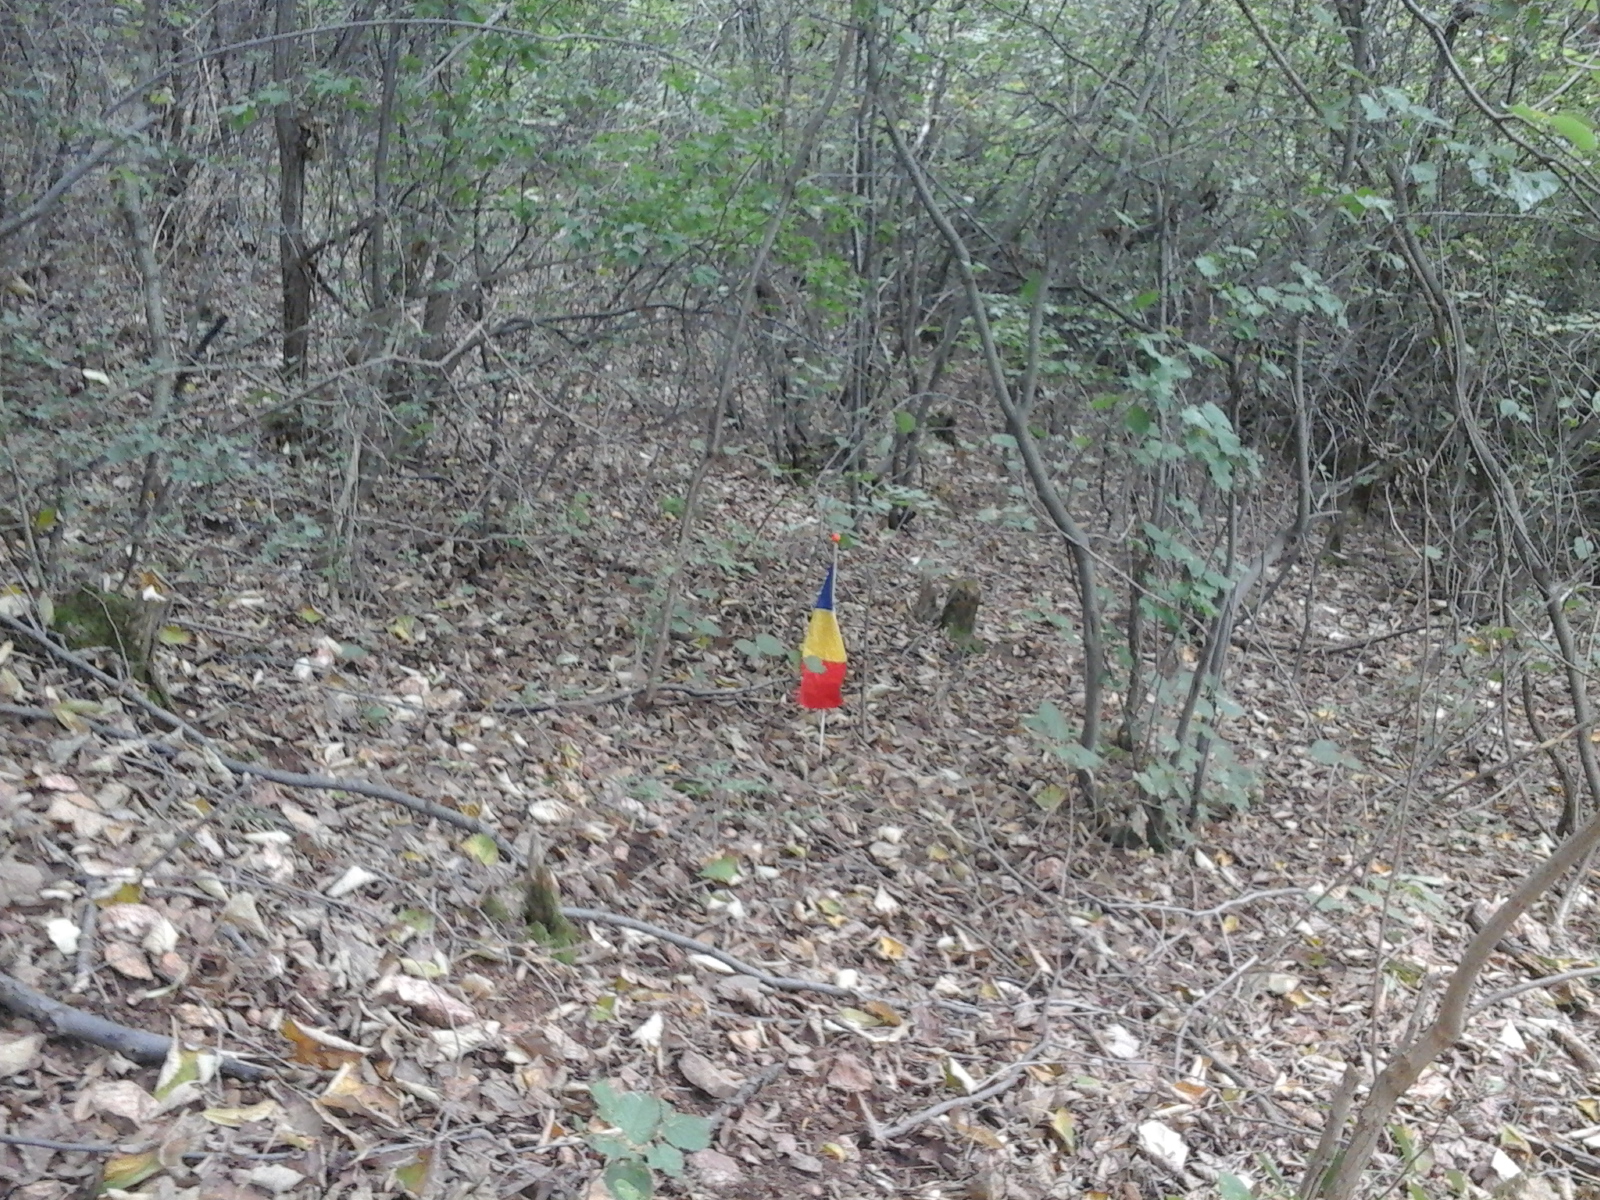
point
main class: Woodland
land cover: Broadleaved woodland
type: beech forest
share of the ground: > 75 %
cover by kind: broadleaved forest trees 100 %
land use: Forestry
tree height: > 5 m
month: August
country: RO
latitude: 46.2758
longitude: 21.6530
